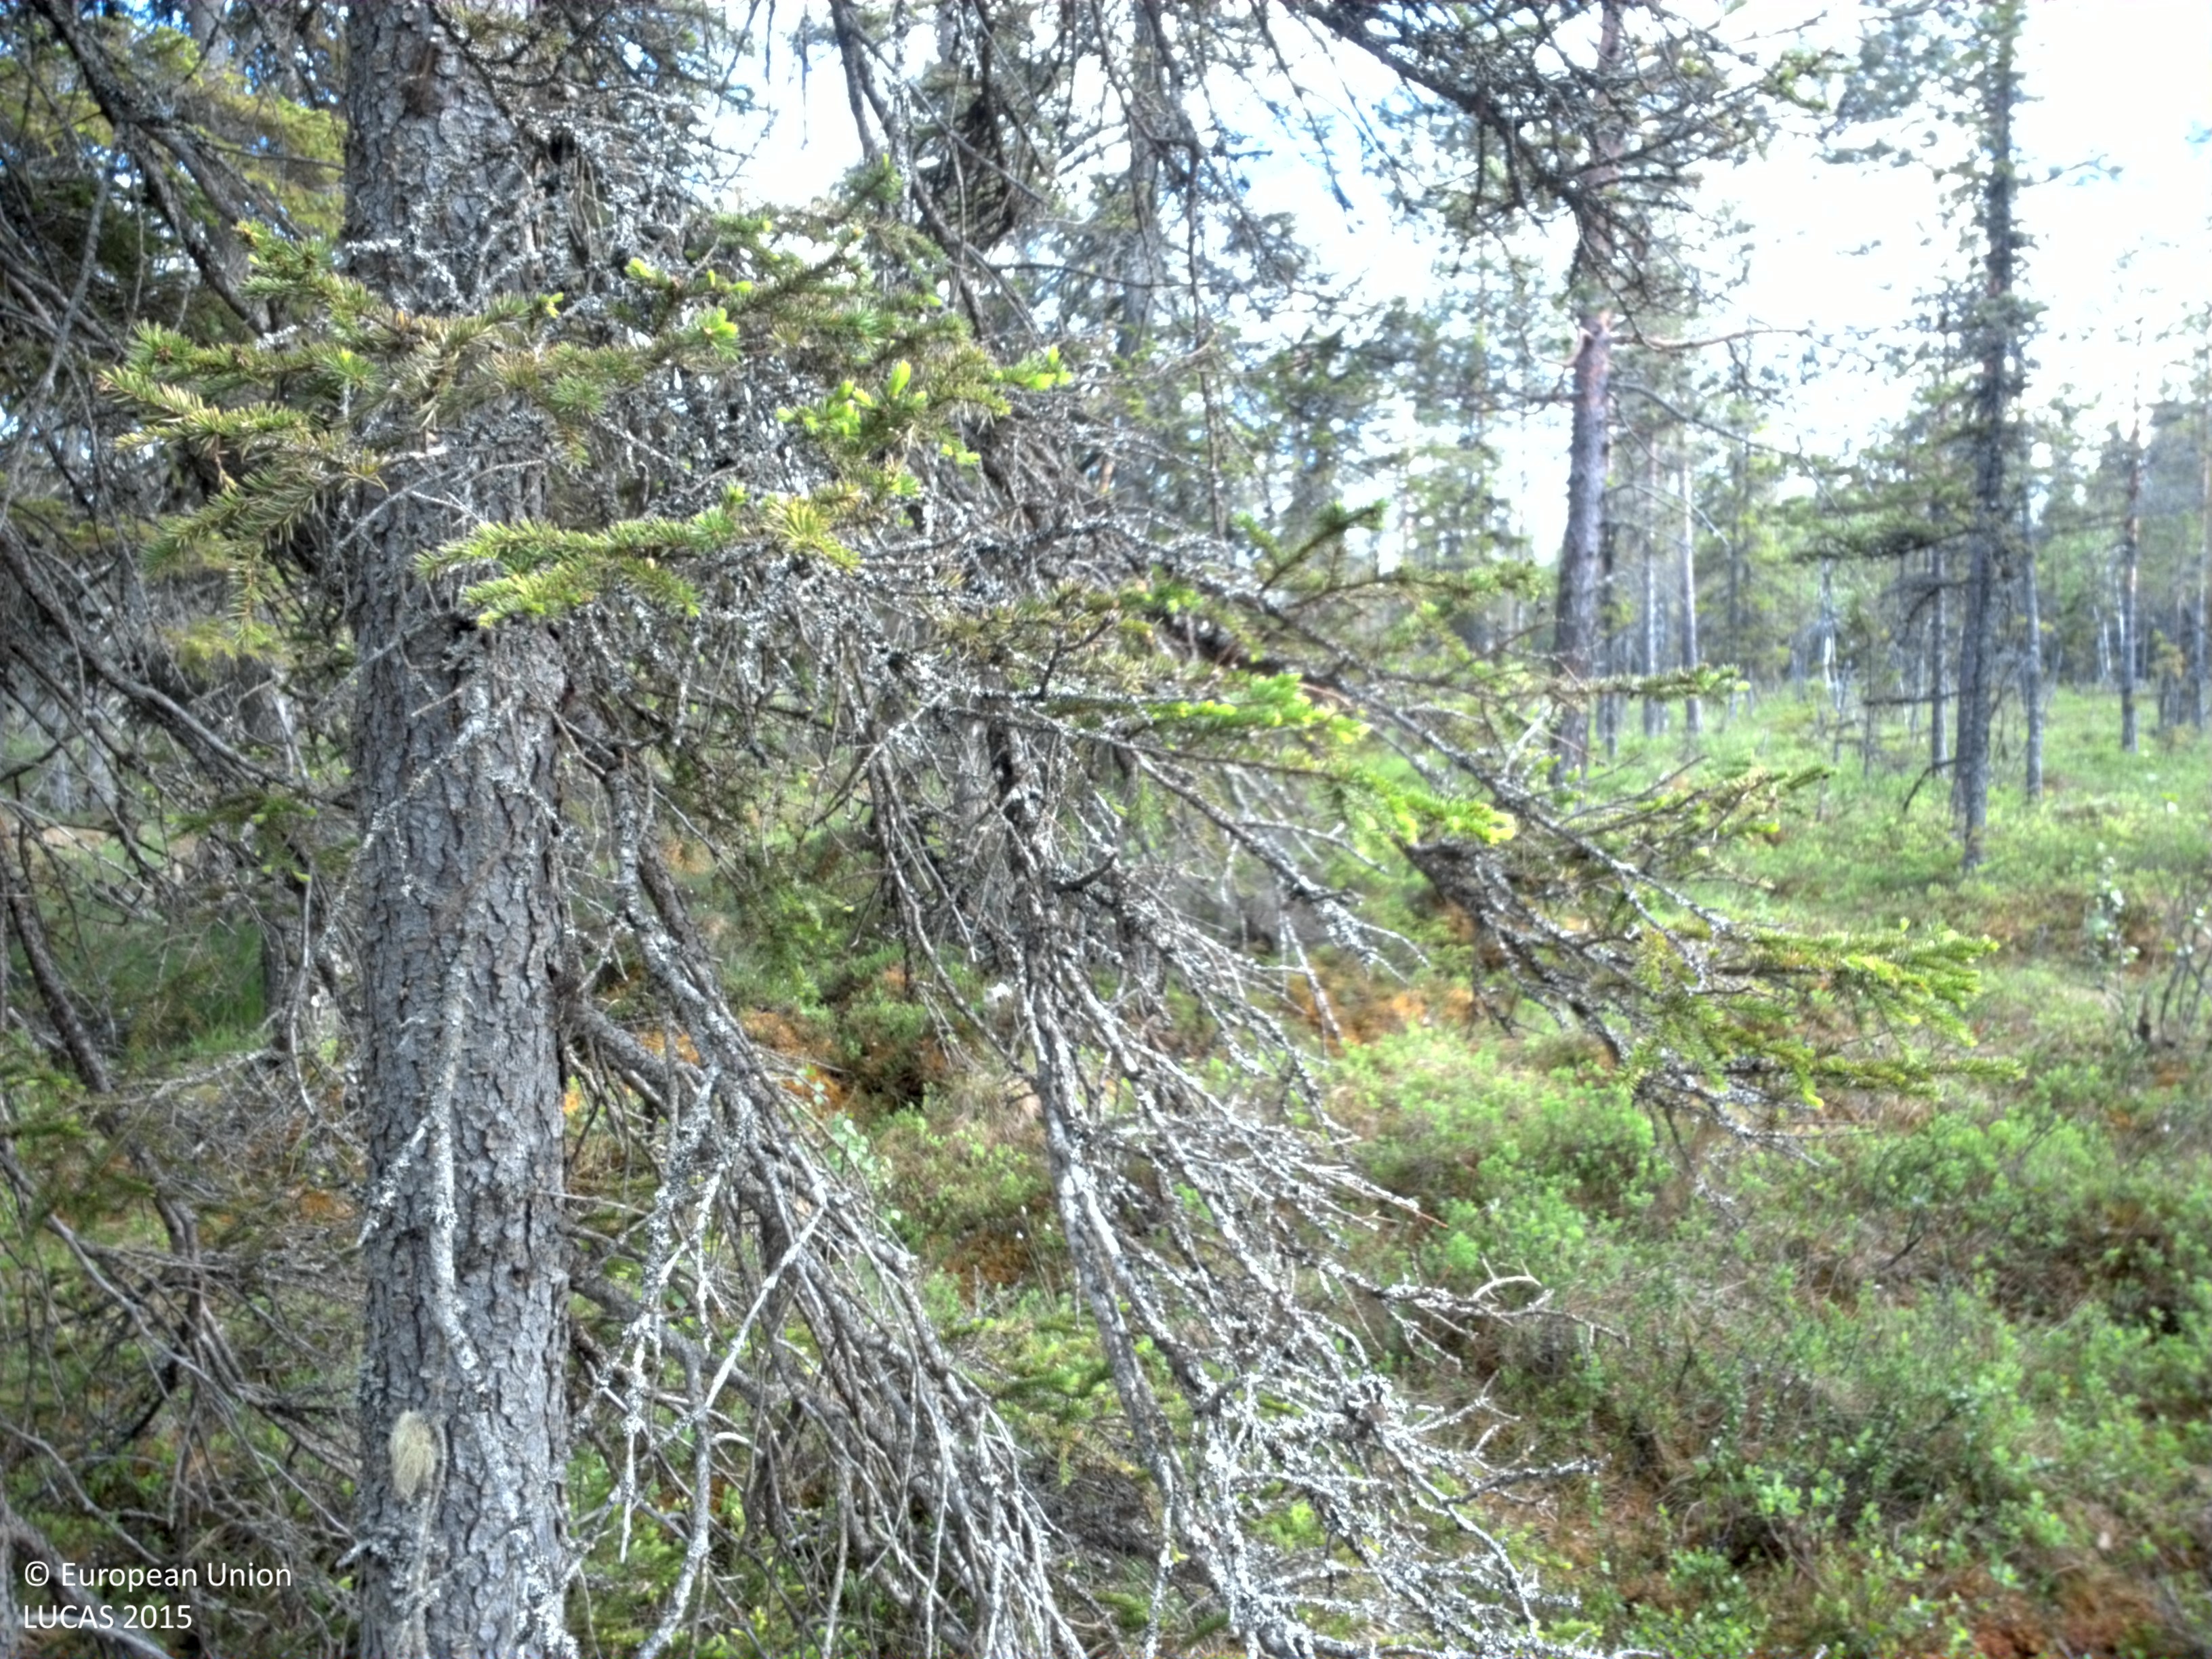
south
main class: Woodland
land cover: Other coniferous woodland
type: boreal forest
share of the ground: 25 - 50 %
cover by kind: shrubs 40 %, coniferous forest trees 25 %, lichens and mosses 20 %, herbaceous plants 15 %
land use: Forestry
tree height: > 5 m
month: June
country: SE
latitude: 61.8512
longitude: 12.5546
